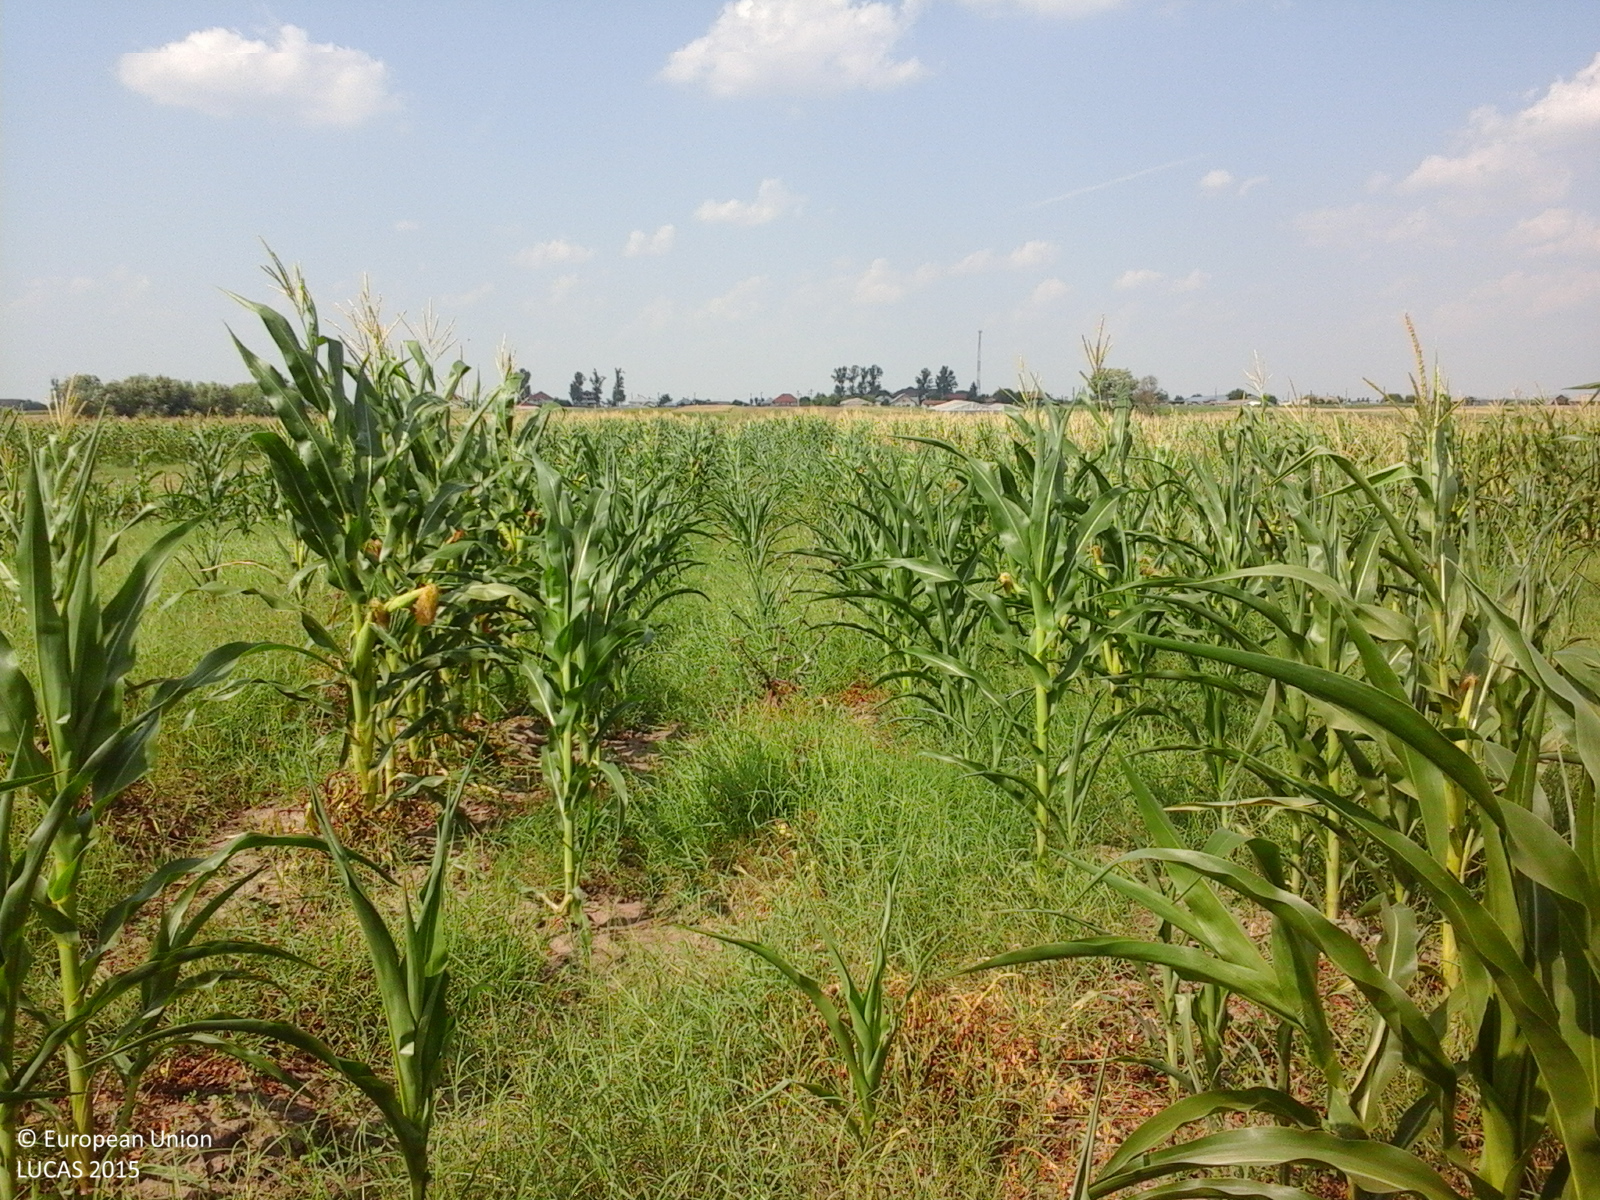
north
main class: Cropland
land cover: Maize
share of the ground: 50 - 75 %
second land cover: Spontaneously vegetated surfaces
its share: 25 - 50 %
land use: Agriculture (excluding fallow land and kitchen gardens)
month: July
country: RO
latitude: 45.8905
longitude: 27.5964
